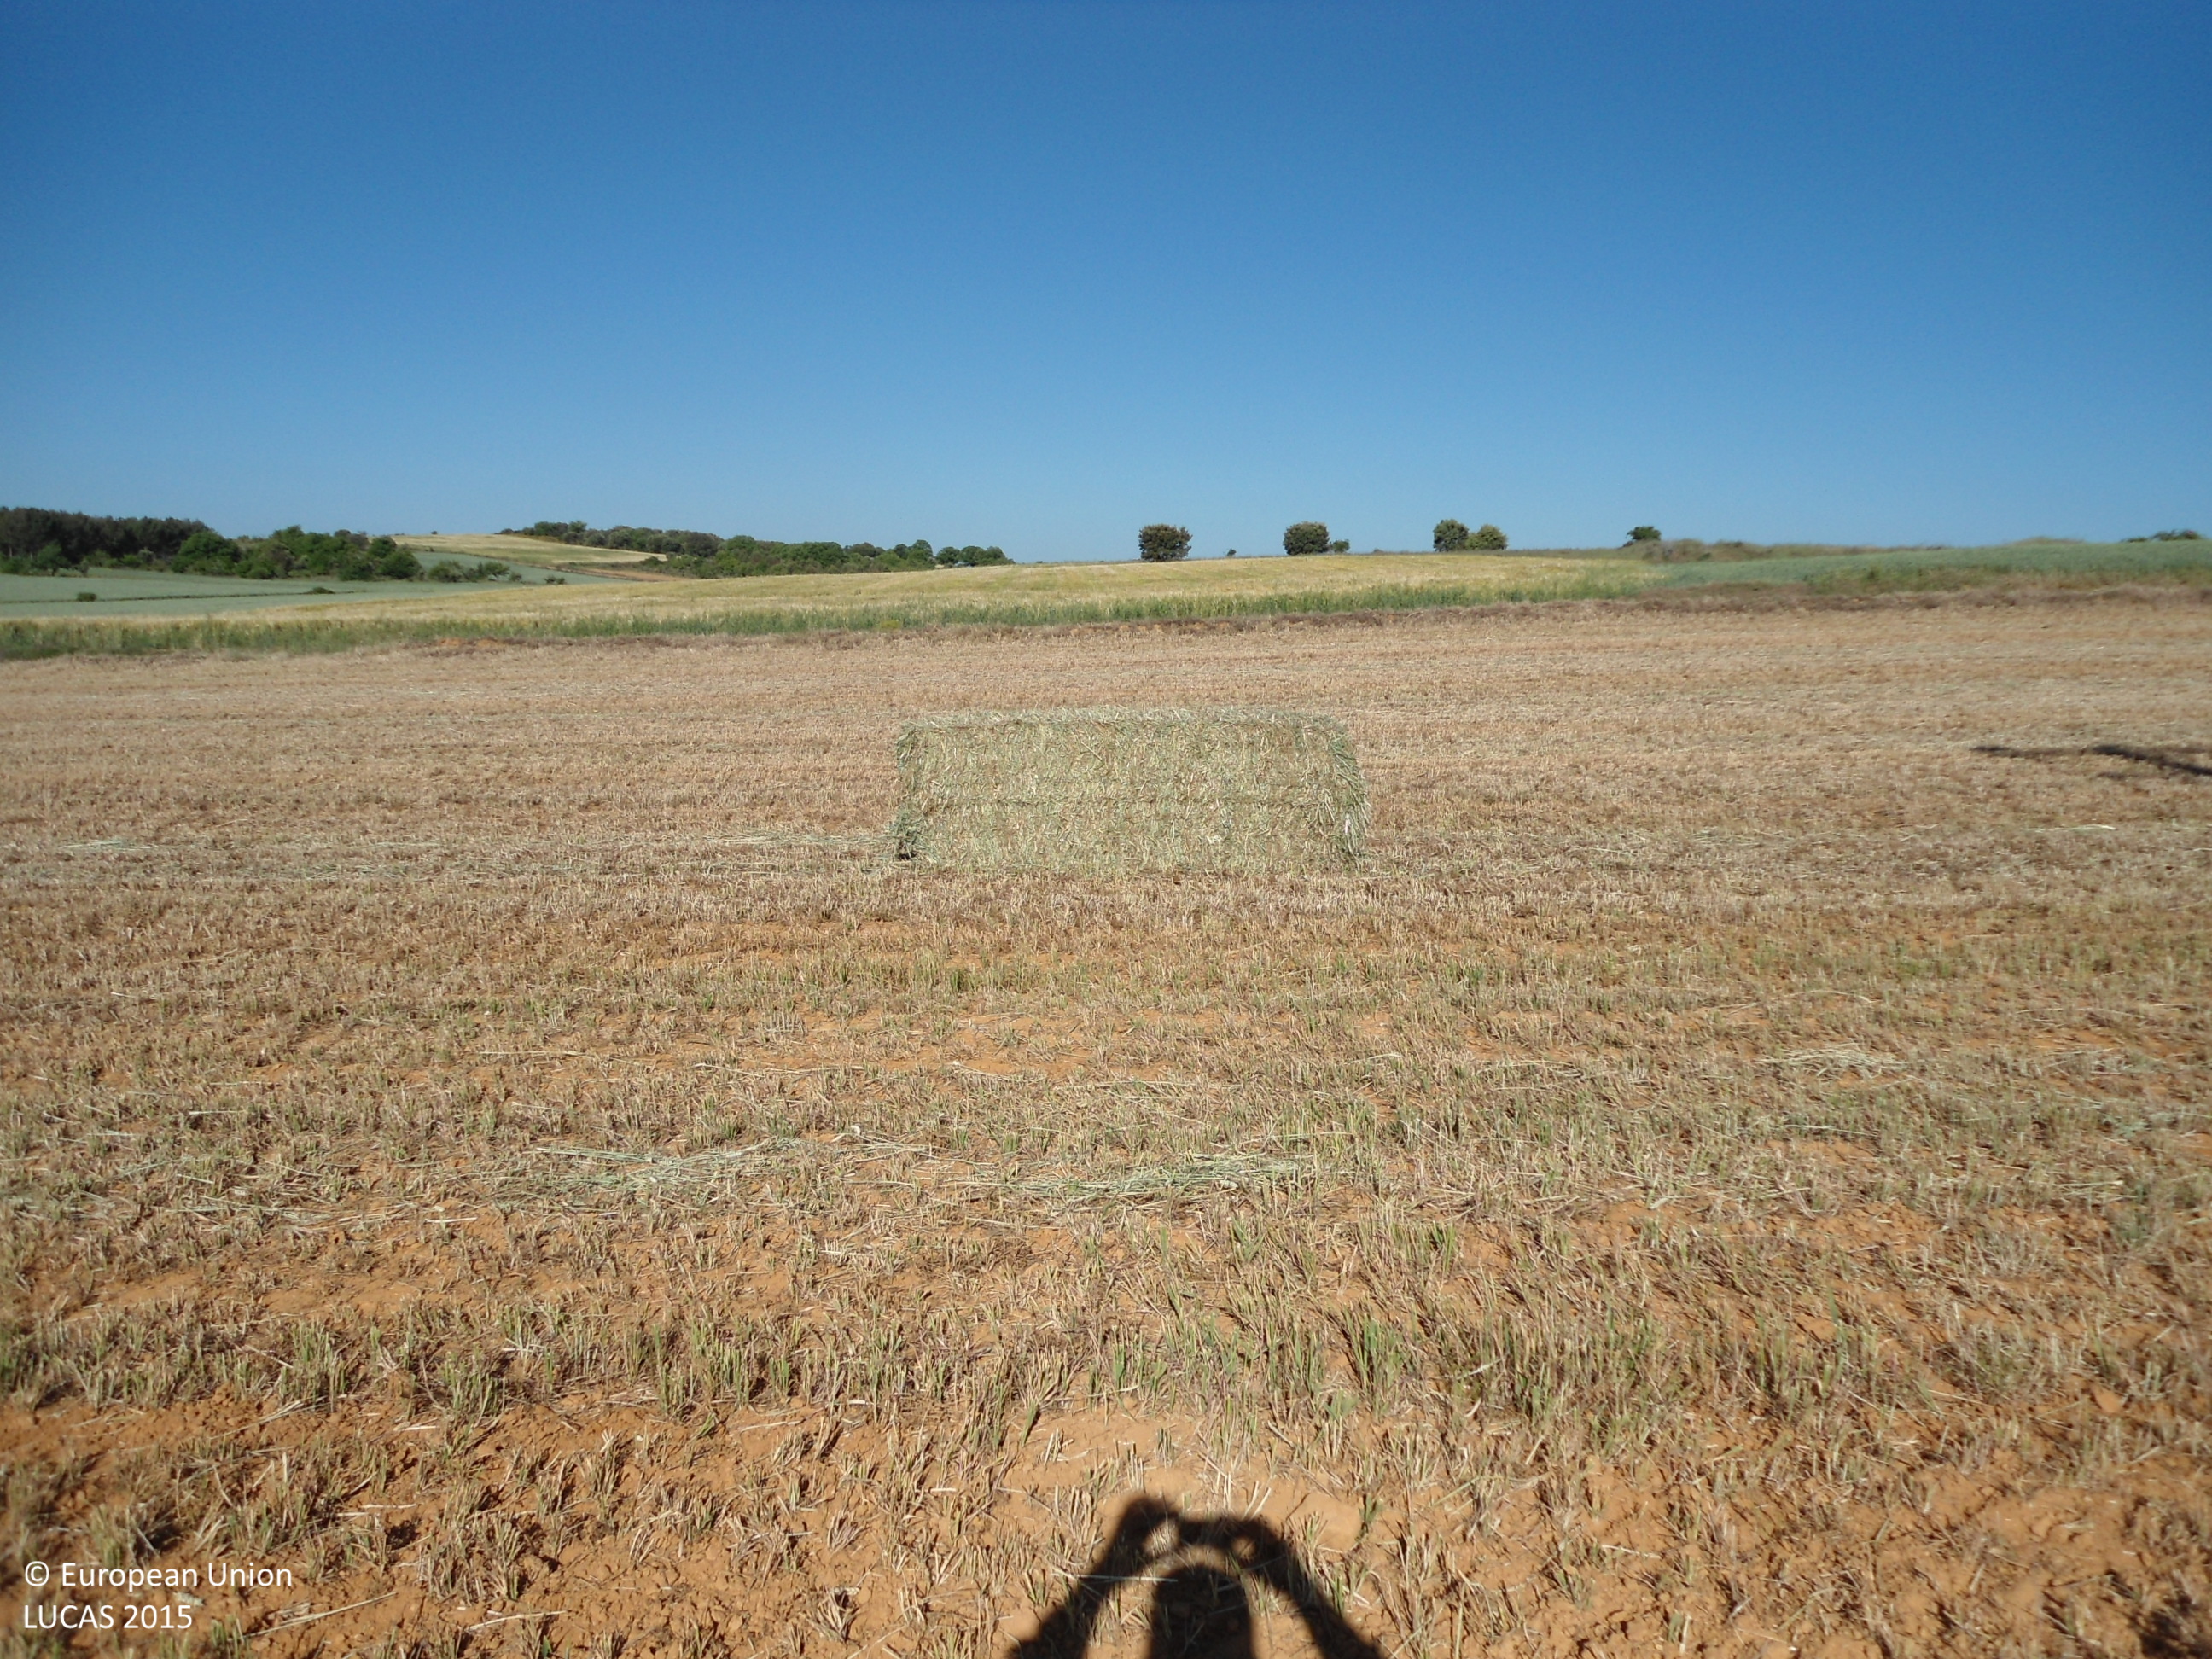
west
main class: Cropland
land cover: Mixed cereals for fodder
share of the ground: > 75 %
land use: Agriculture (excluding fallow land and kitchen gardens)
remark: Harvested field
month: May
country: ES
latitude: 42.0680
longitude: -6.0167
